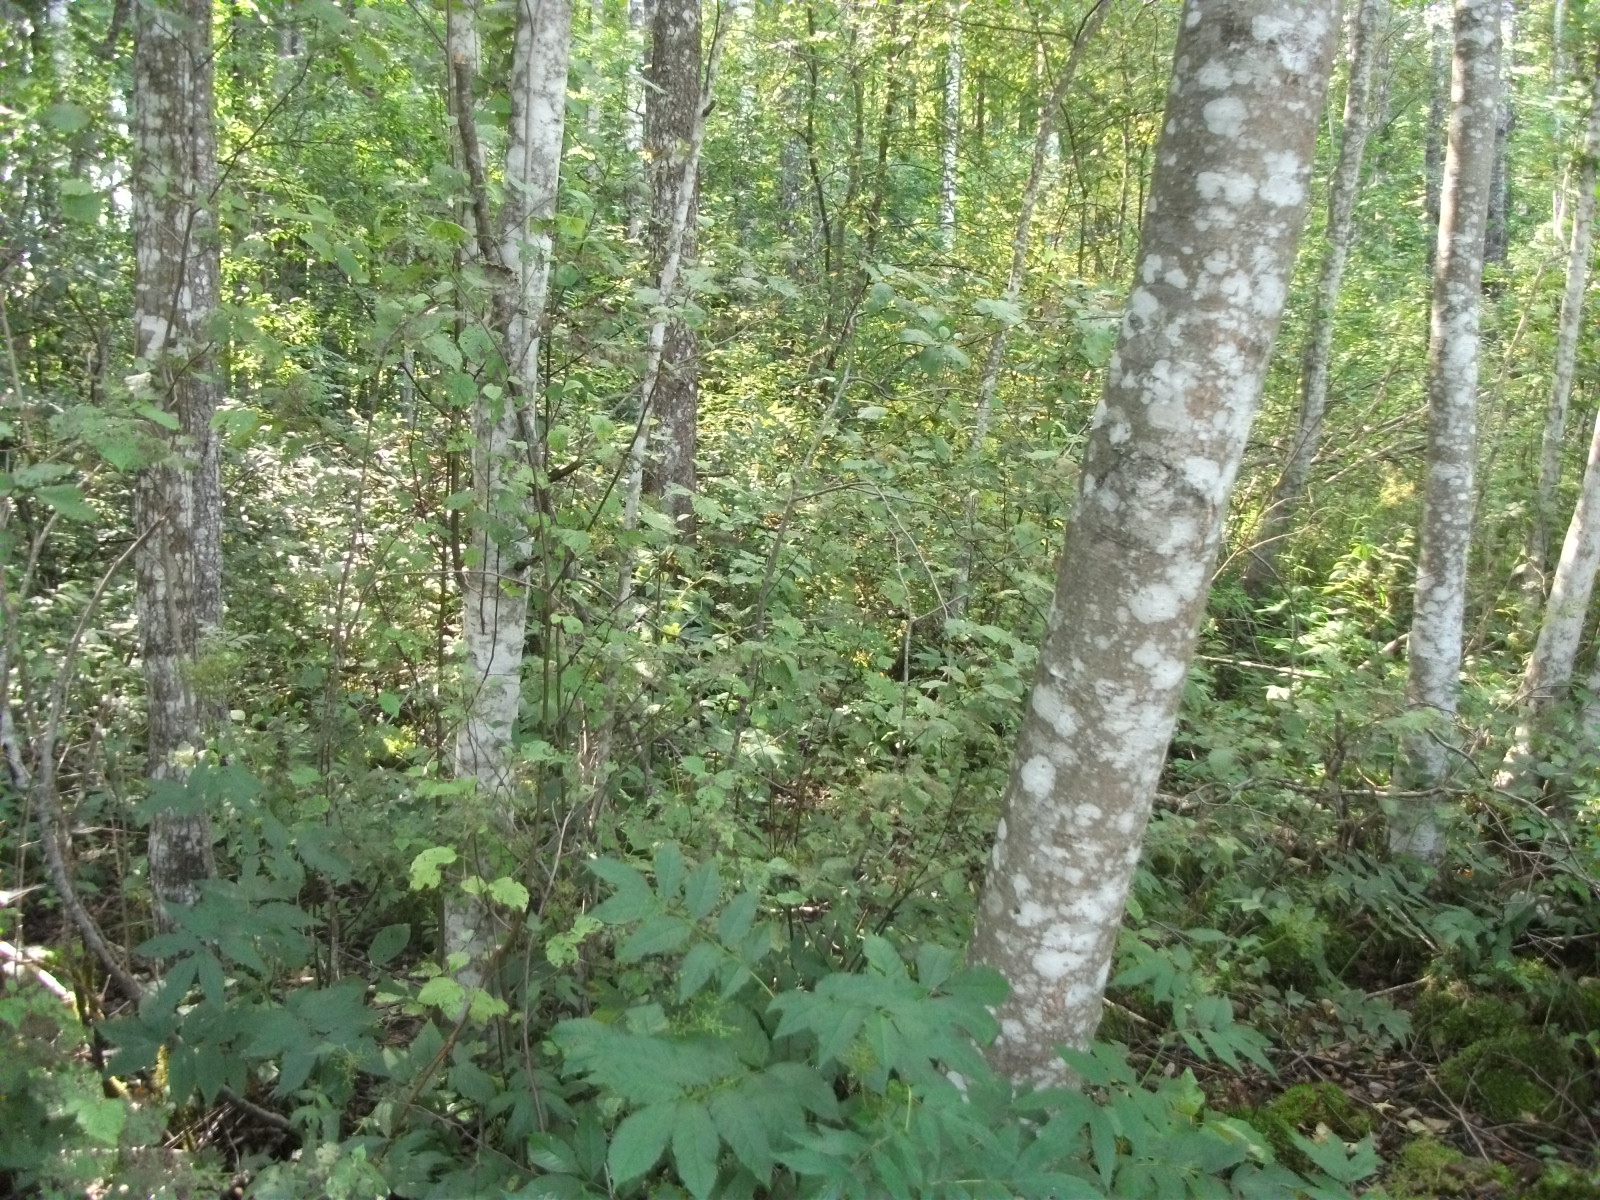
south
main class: Woodland
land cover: Broadleaved woodland
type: non-riverine alder, birch or aspen forest
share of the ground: > 75 %
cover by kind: broadleaved forest trees 90 %, shrubs 5 %, herbaceous plants 5 %
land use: Forestry
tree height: > 5 m
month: August
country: LV
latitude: 56.9045
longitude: 26.4163
